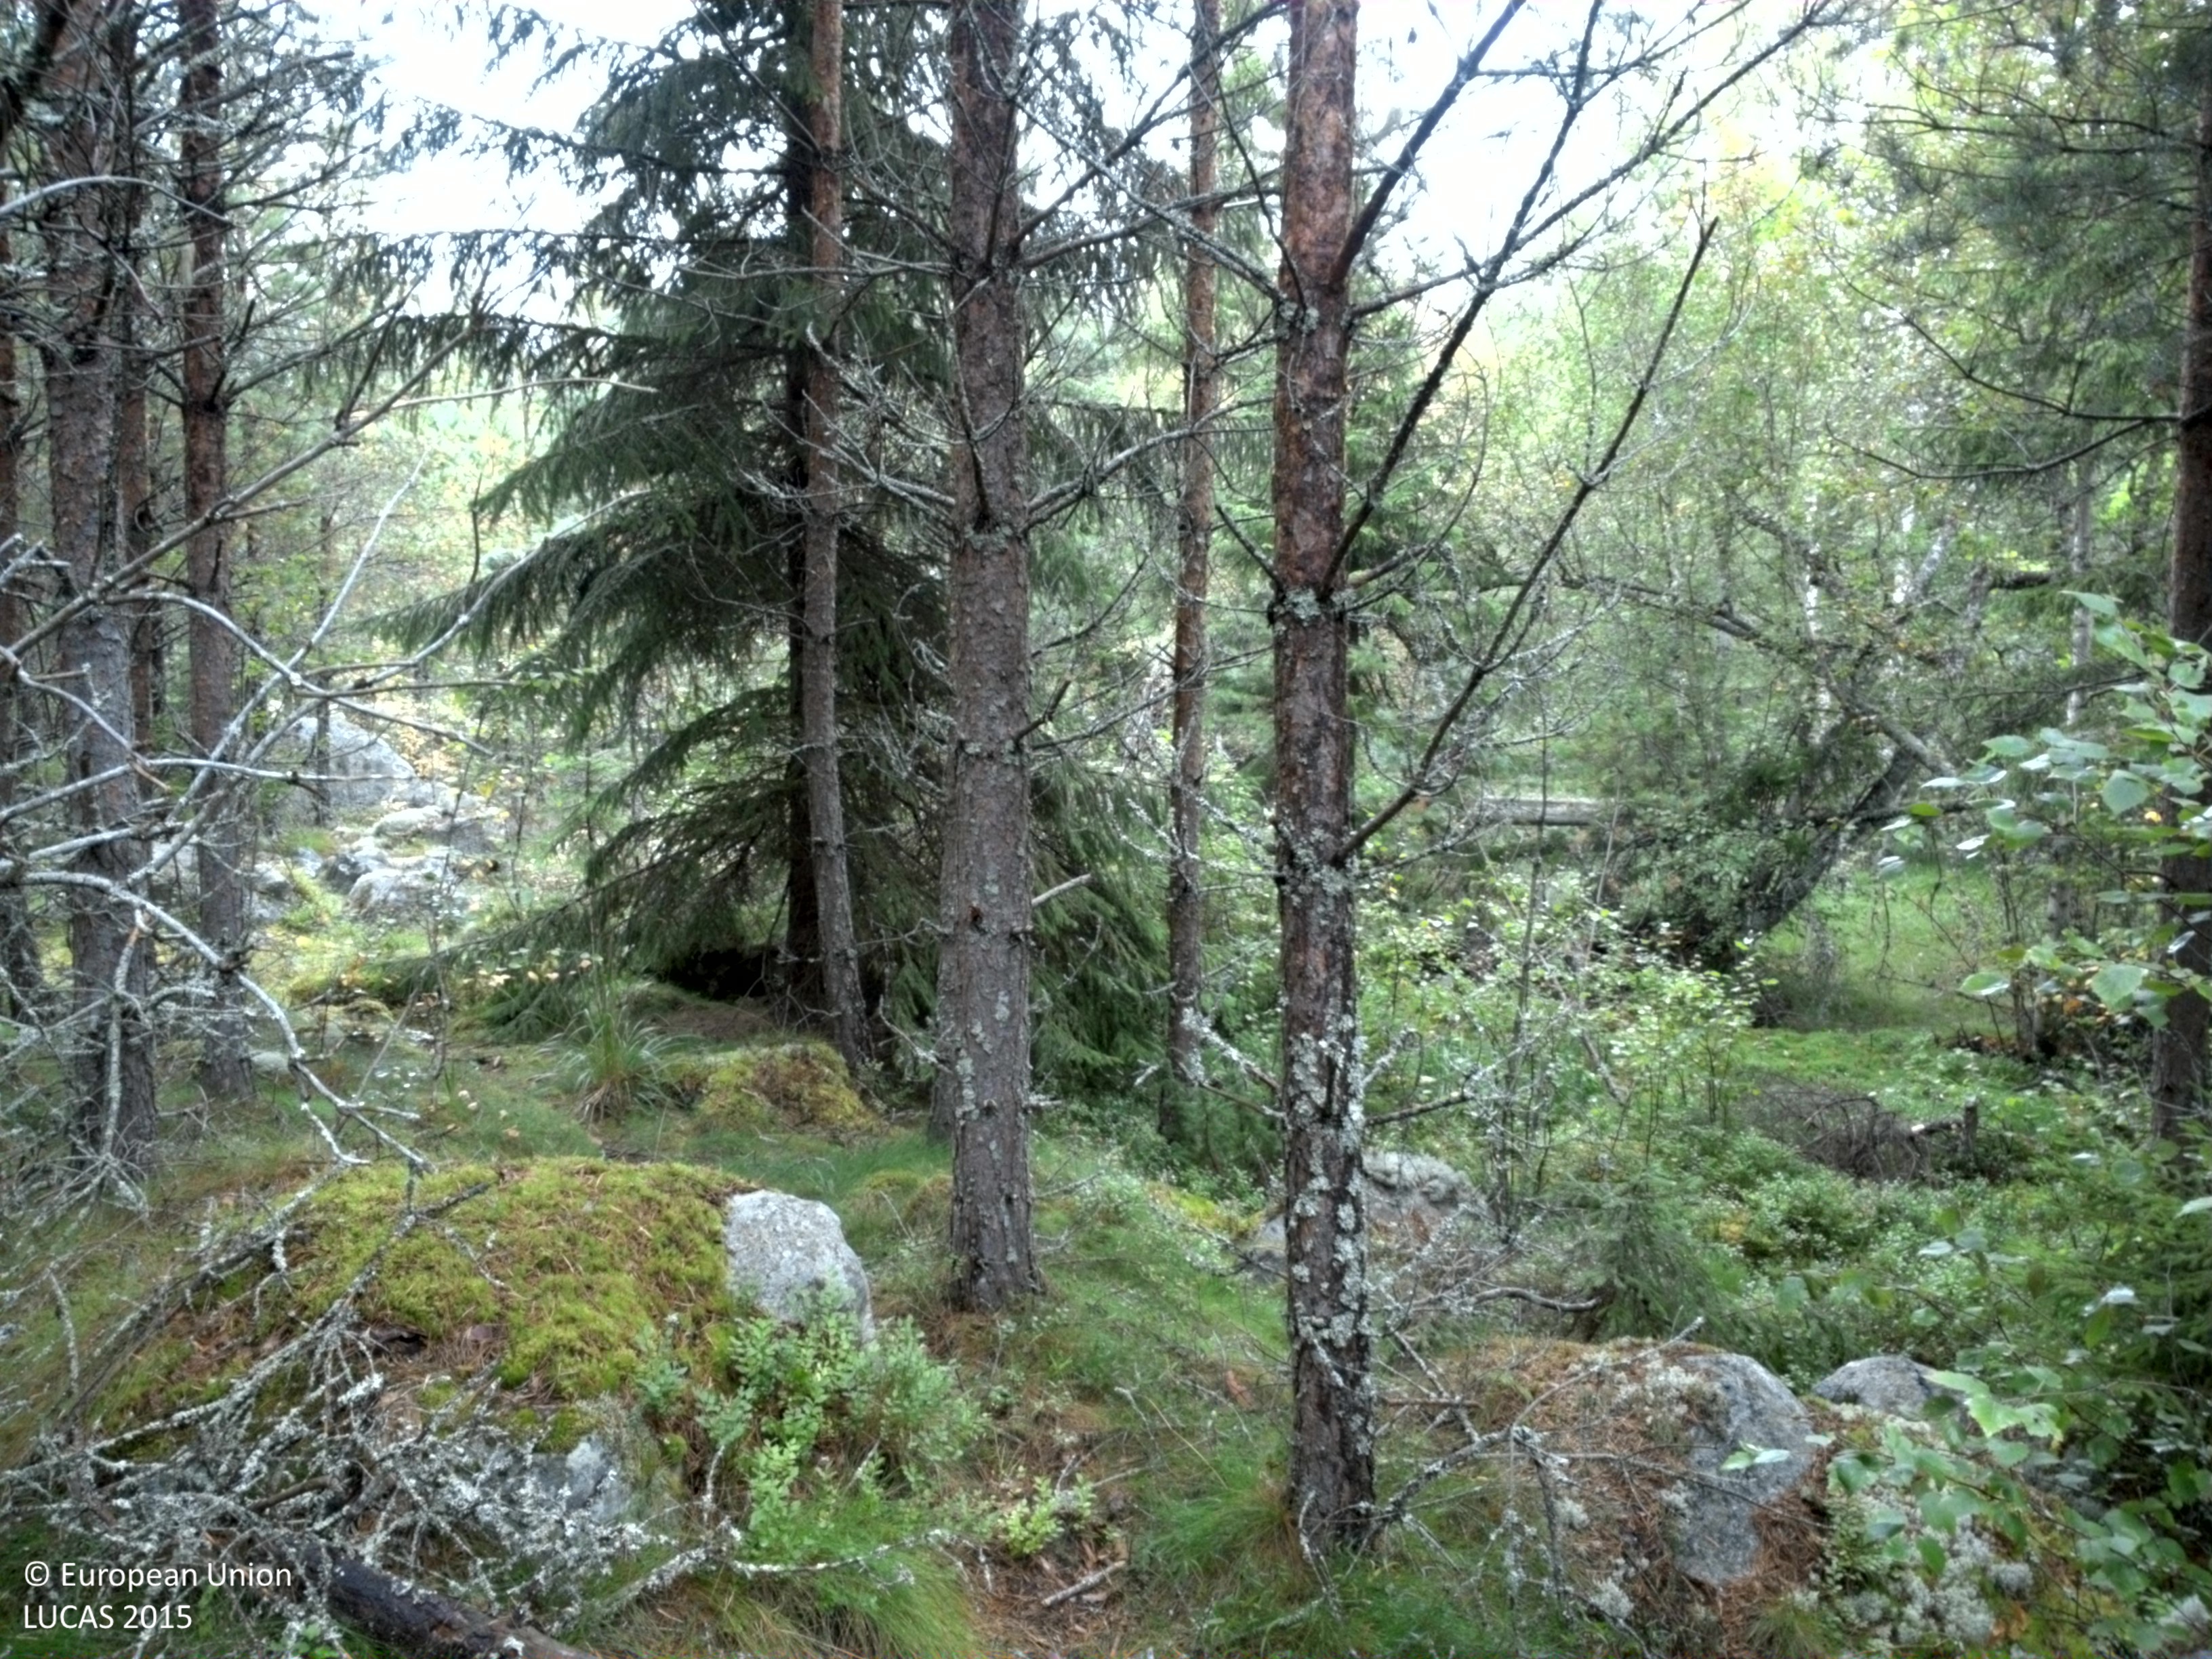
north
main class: Woodland
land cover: Pine dominated coniferous woodland
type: boreal forest
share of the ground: 50 - 75 %
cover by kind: coniferous forest trees 65 %, herbaceous plants 25 %, broadleaved forest trees 10 %
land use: Forestry
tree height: > 5 m
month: August
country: SE
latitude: 59.9355
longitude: 17.6713
